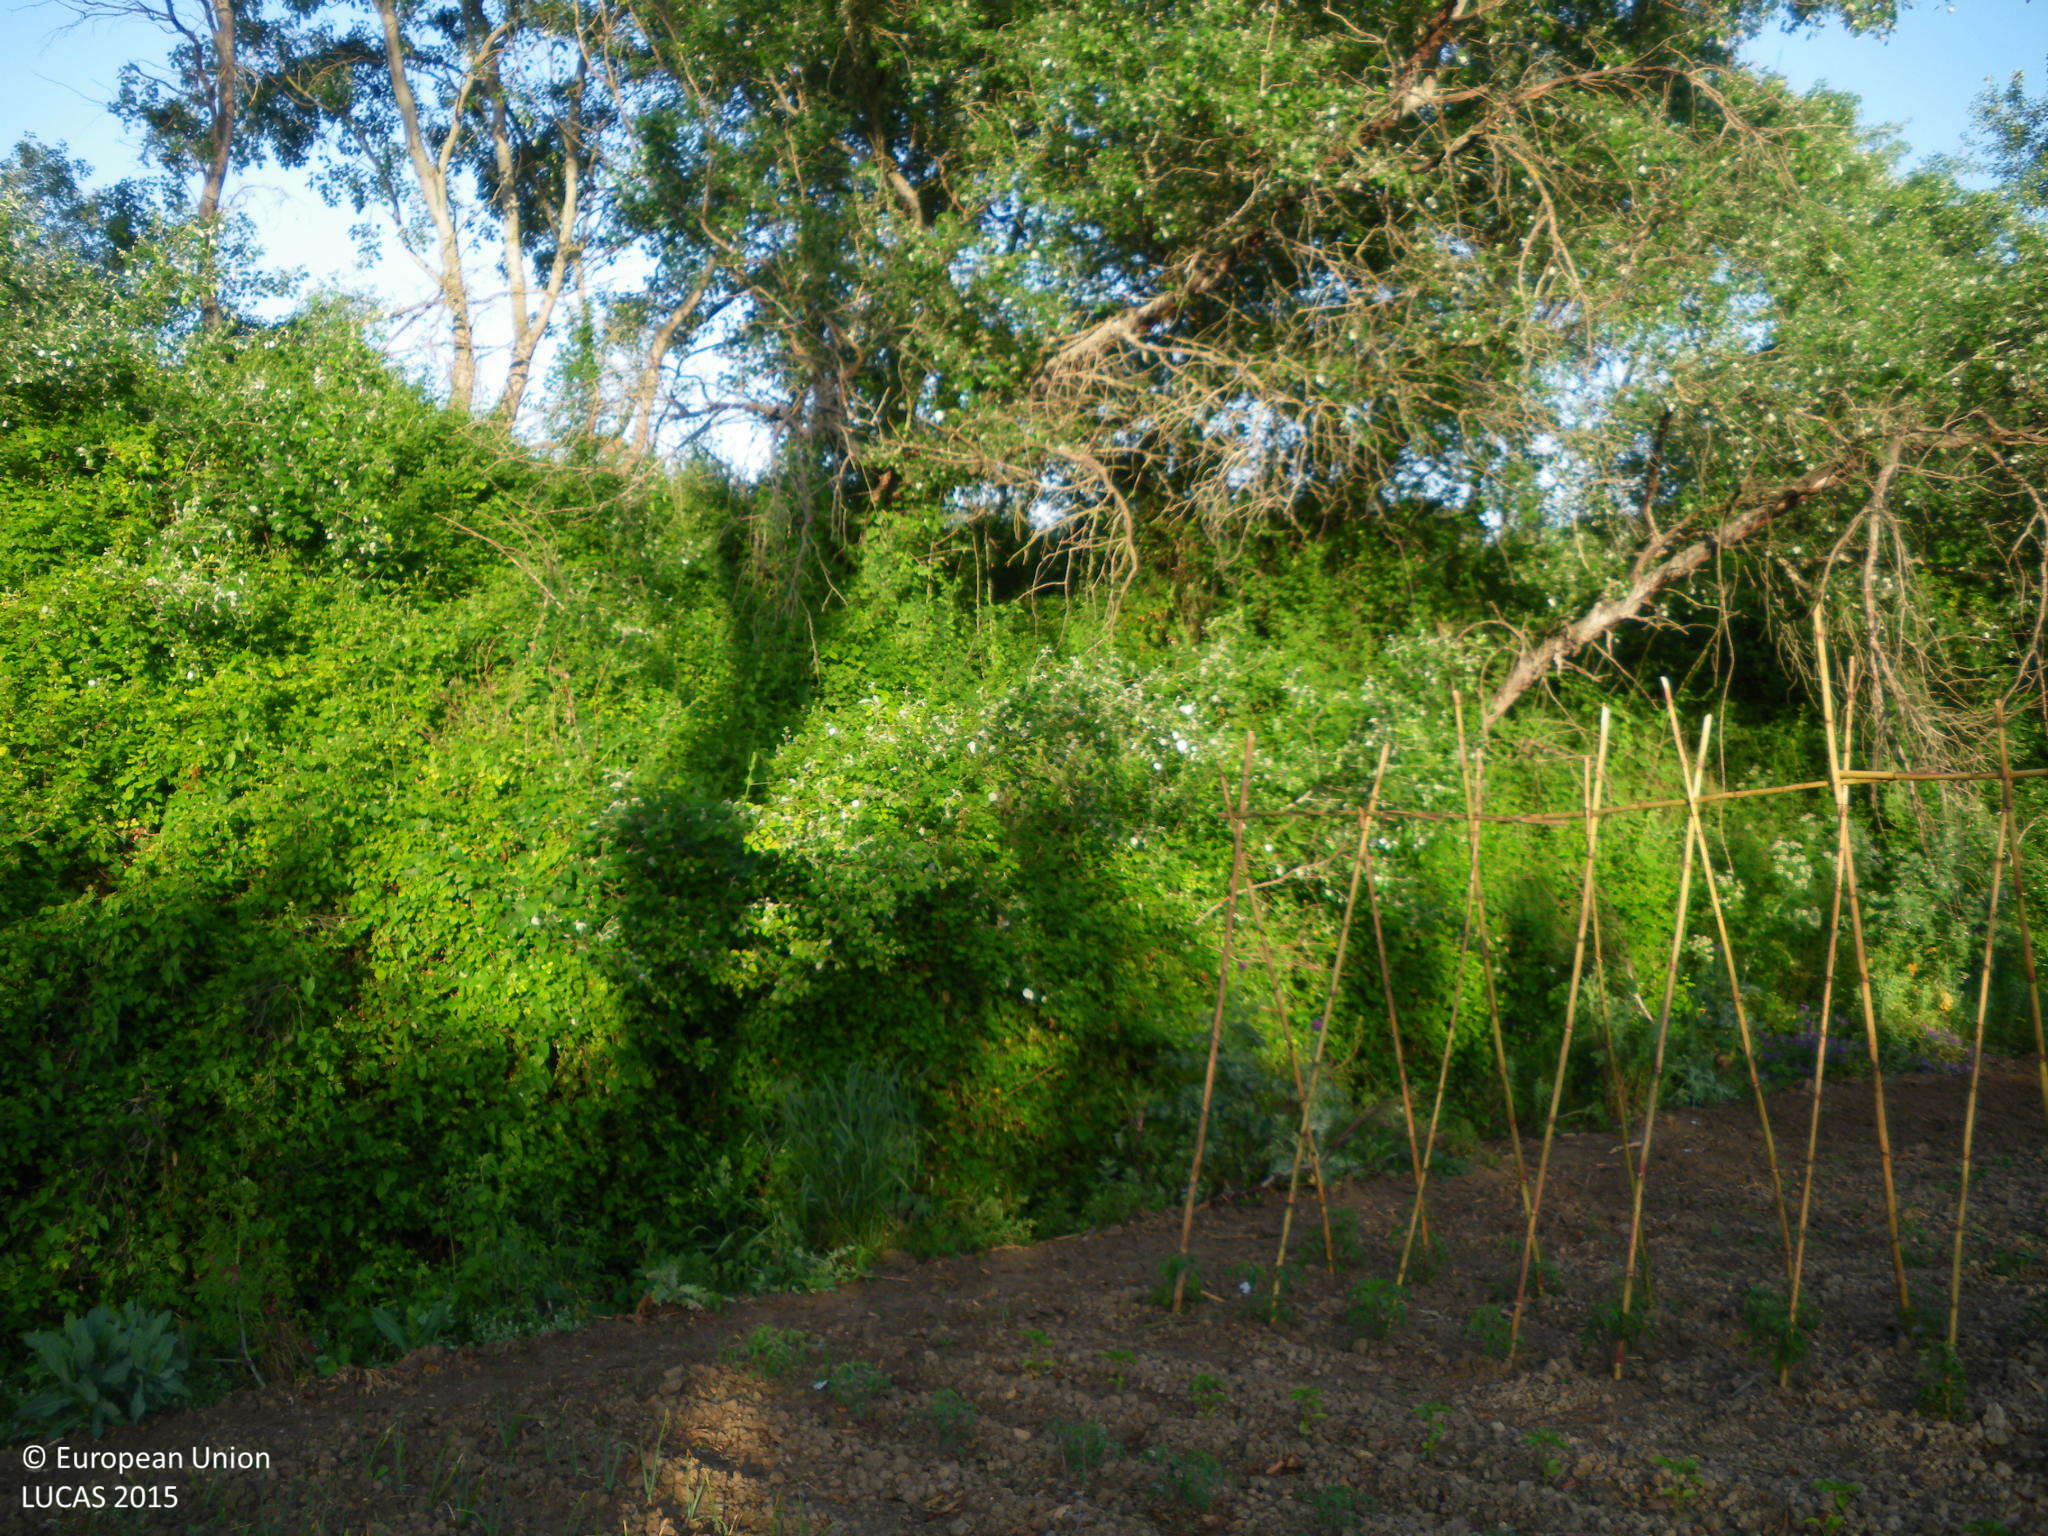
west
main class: Woodland
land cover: Broadleaved woodland
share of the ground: 25 - 50 %
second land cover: Other fresh vegetables
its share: < 10 %
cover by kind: unconsolidated bare surface 70 %, broadleaved forest trees 25 %, herbaceous plants 5 %
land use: Forestry
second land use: Agriculture (excluding fallow land and kitchen gardens)
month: April
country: ES
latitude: 36.6148
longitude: -5.9405
